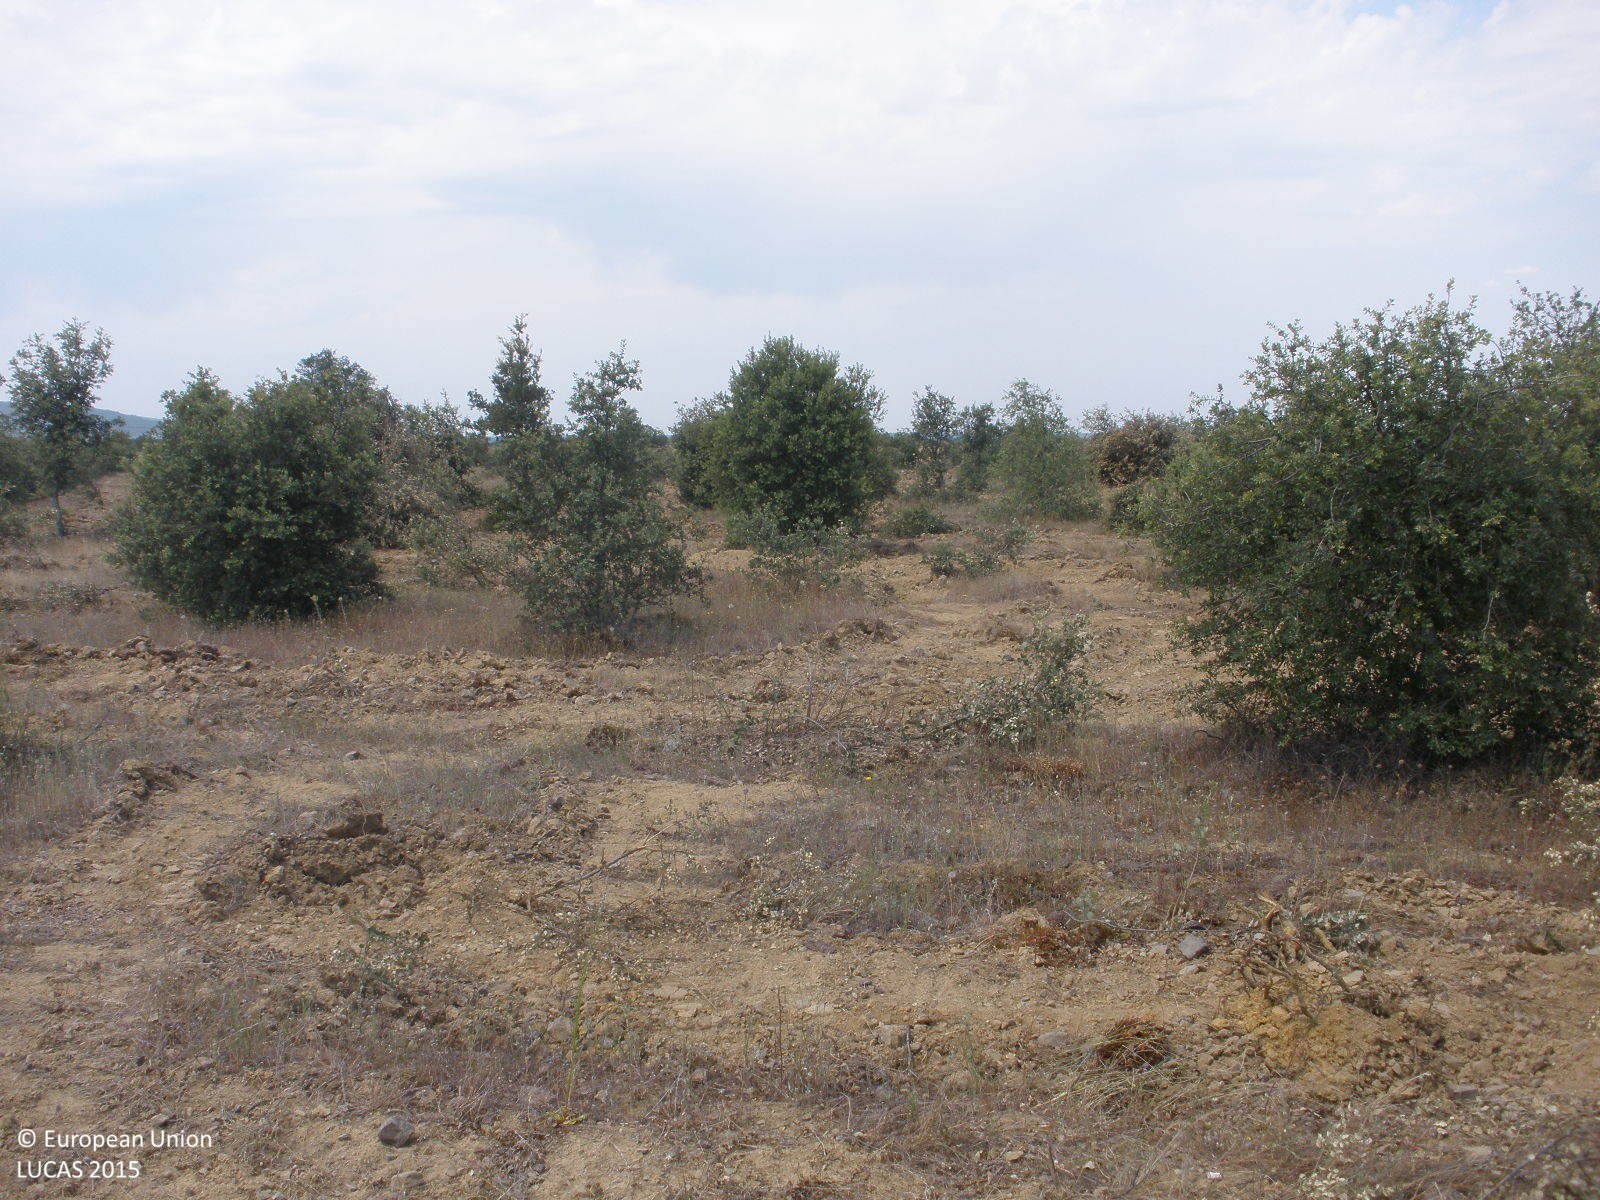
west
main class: Woodland
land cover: Broadleaved woodland
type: broadleaved evergreen forest
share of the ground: 50 - 75 %
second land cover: Spontaneously vegetated surfaces
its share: 25 - 50 %
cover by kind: broadleaved forest trees 50 %, unconsolidated bare surface 40 %, herbaceous plants 10 %
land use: Forestry
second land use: Fallow land
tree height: < 5 m
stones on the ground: > 50 %
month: June
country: ES
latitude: 40.6078
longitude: -6.2881
